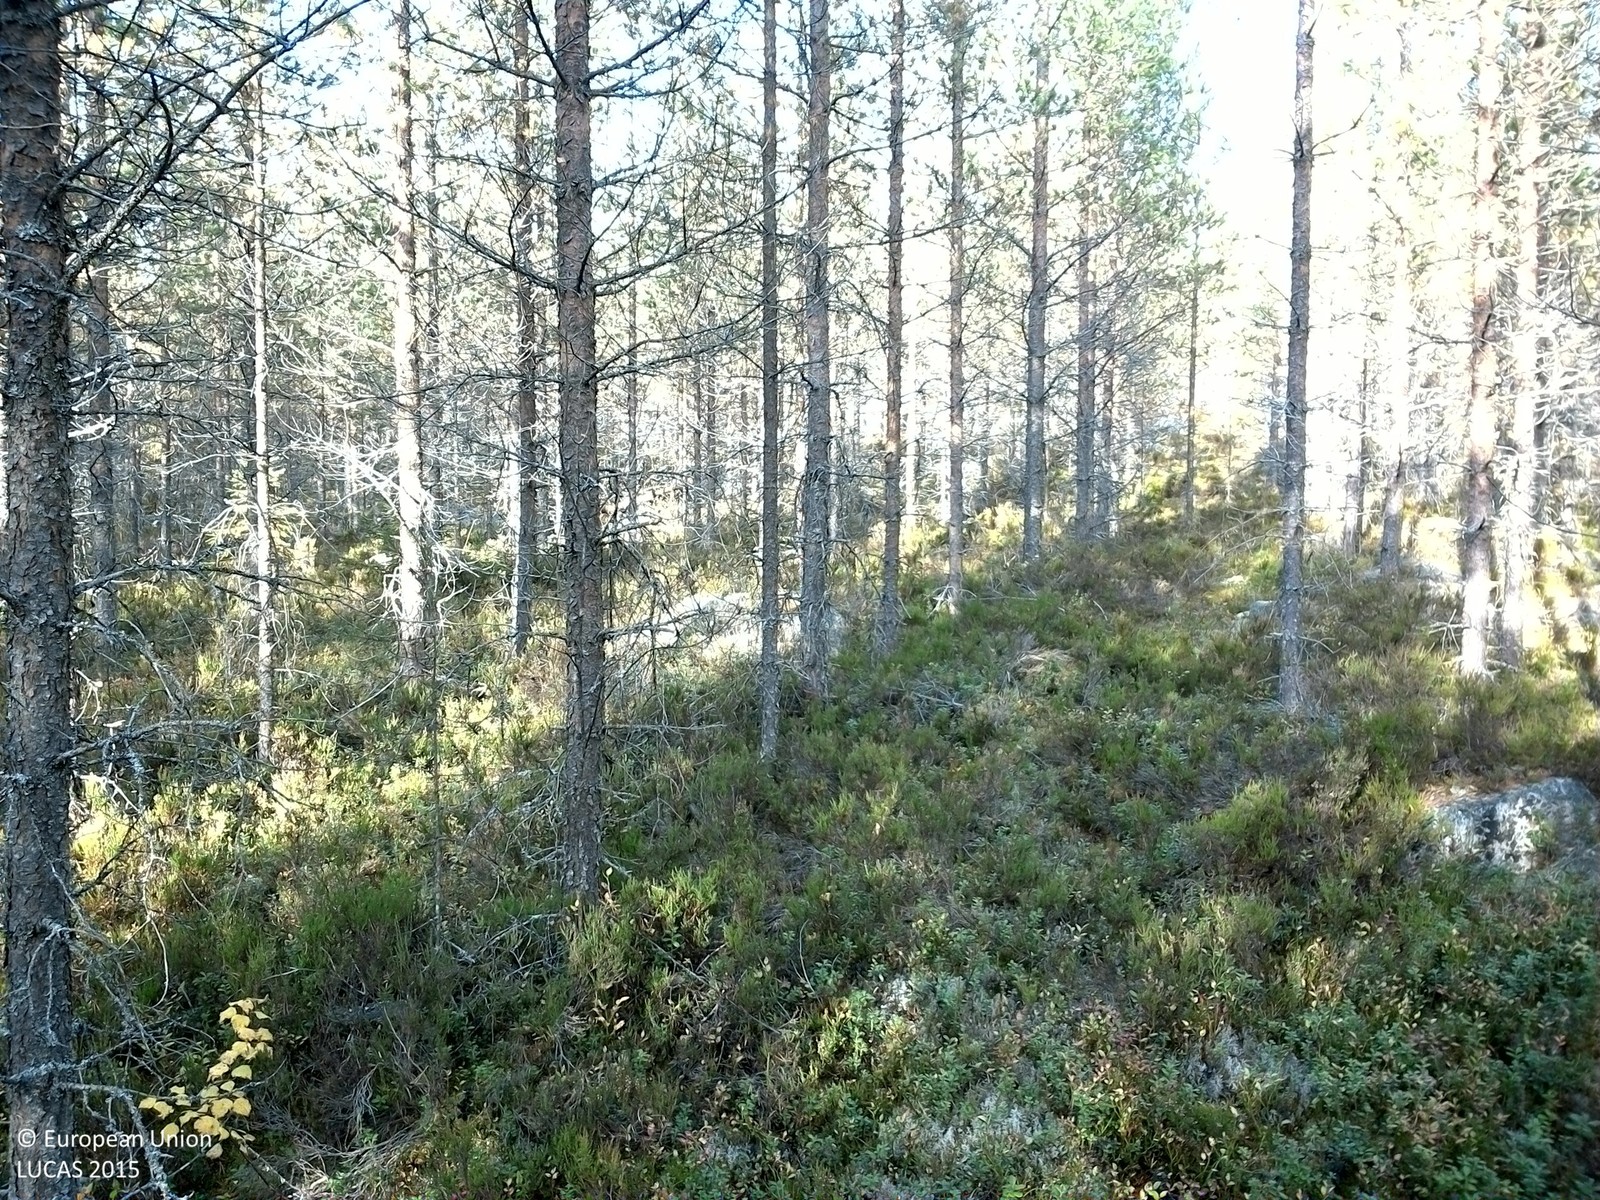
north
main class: Woodland
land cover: Pine dominated coniferous woodland
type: boreal forest
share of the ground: 50 - 75 %
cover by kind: coniferous forest trees 75 %, shrubs 15 %, lichens and mosses 5 %, consolidated bare surface 5 %
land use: Forestry
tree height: > 5 m
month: October
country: SE
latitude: 61.4421
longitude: 15.1037
